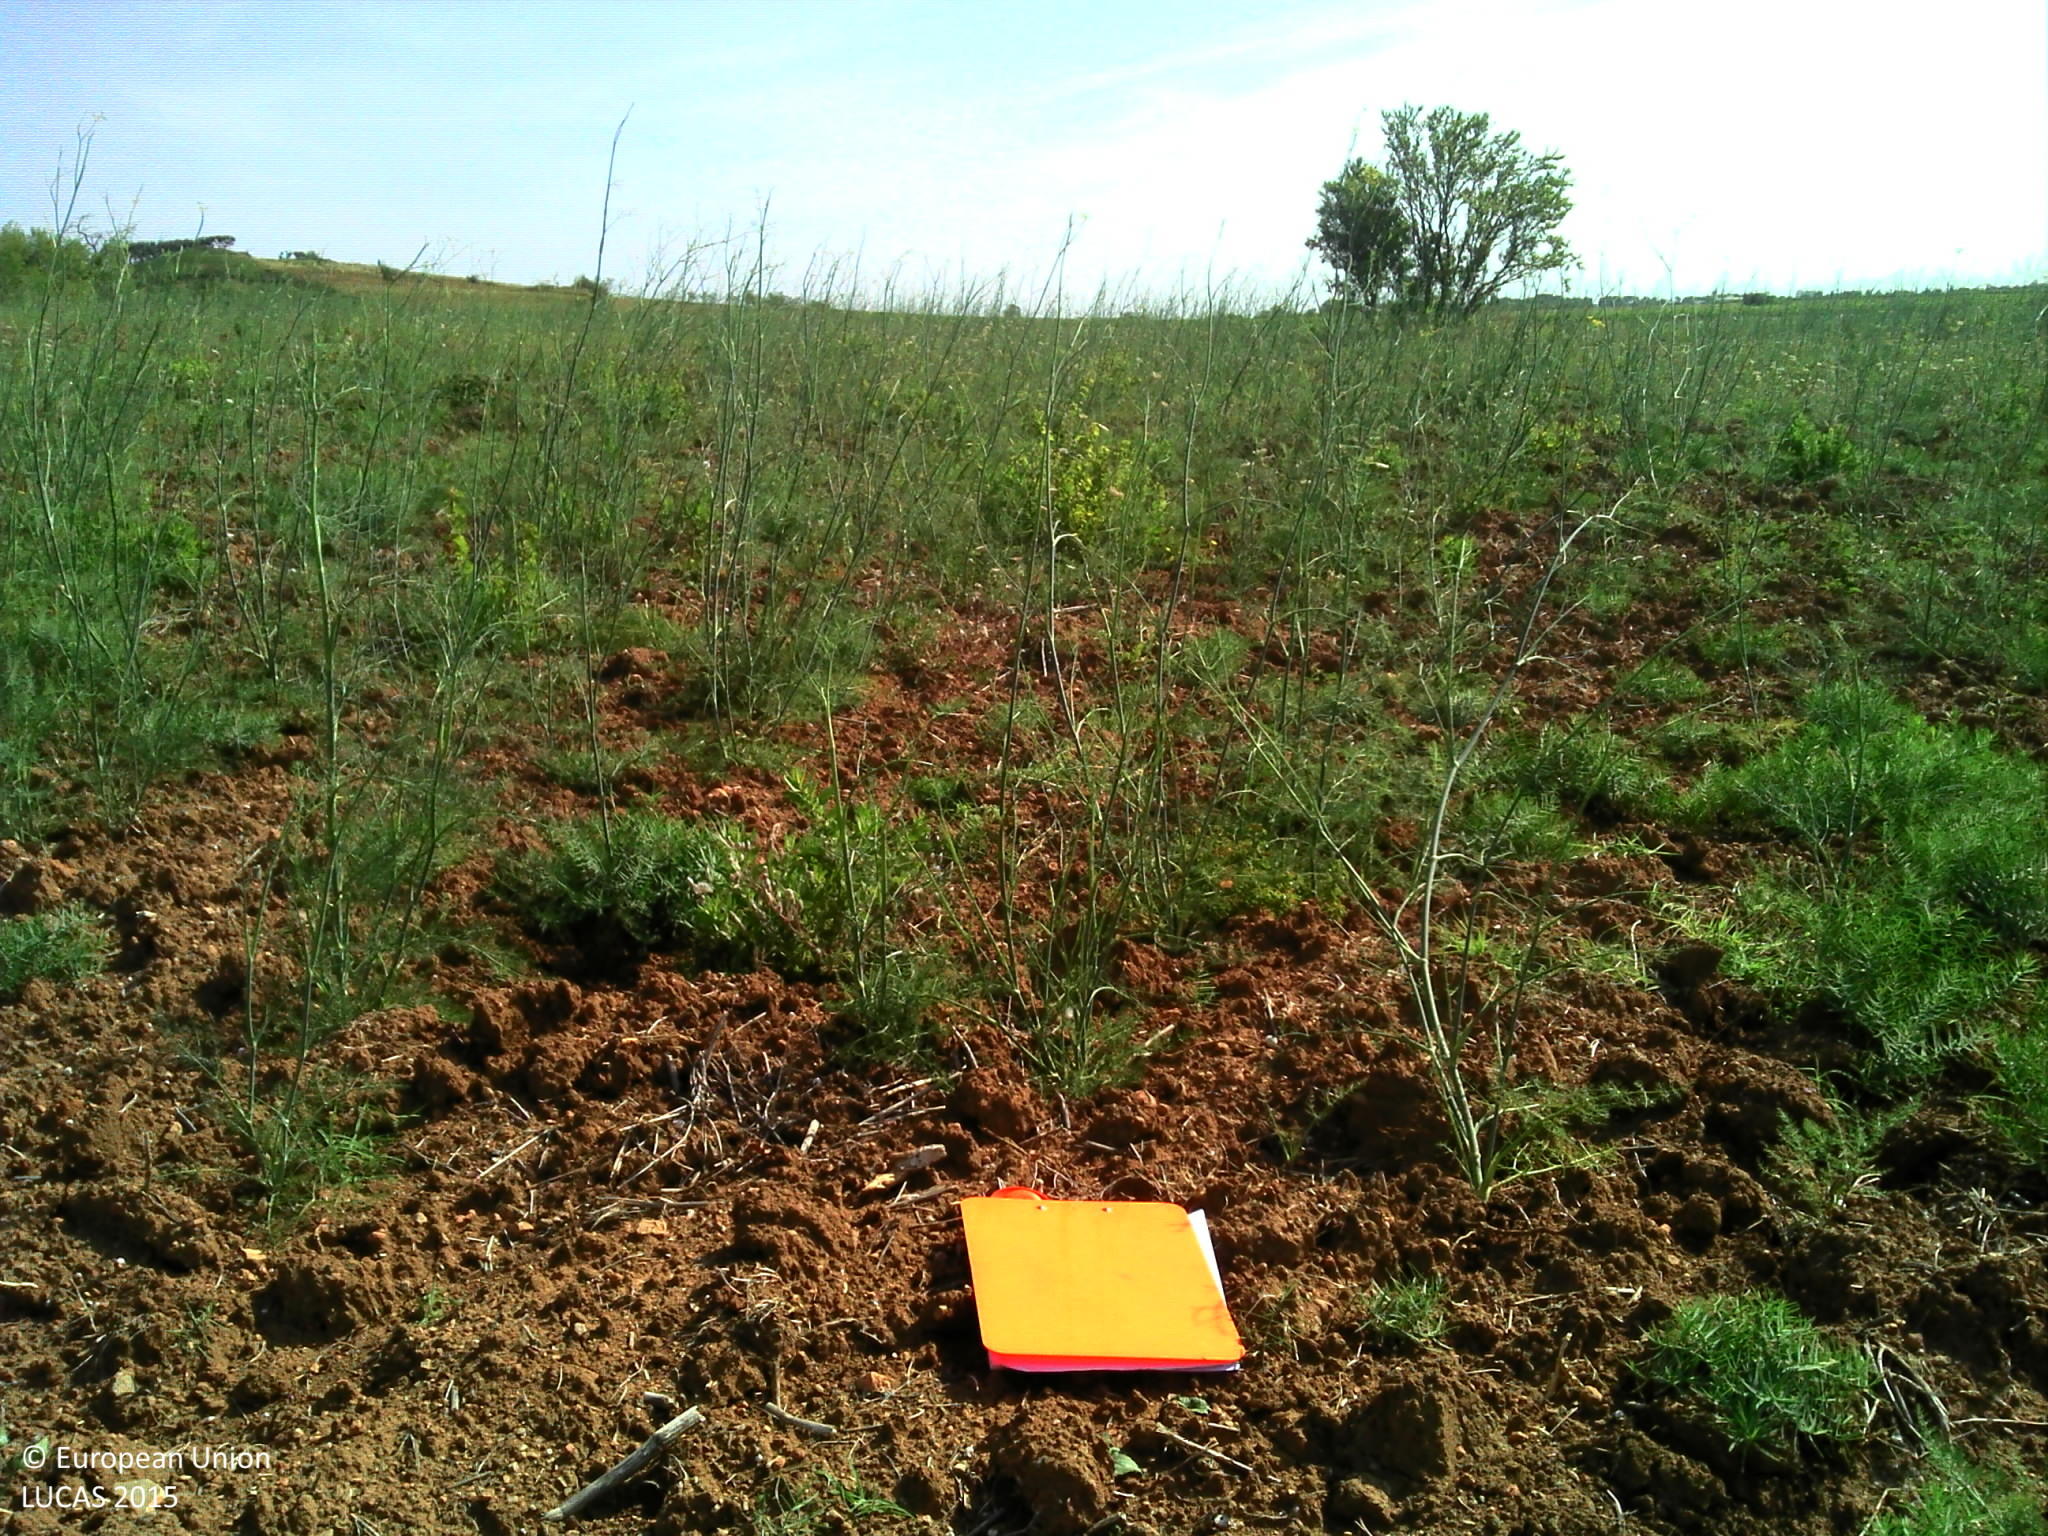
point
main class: Grassland
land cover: Spontaneously vegetated surfaces
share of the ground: > 75 %
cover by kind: herbaceous plants 100 %
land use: Fallow land
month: July
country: FR
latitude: 43.1707
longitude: 2.7148
